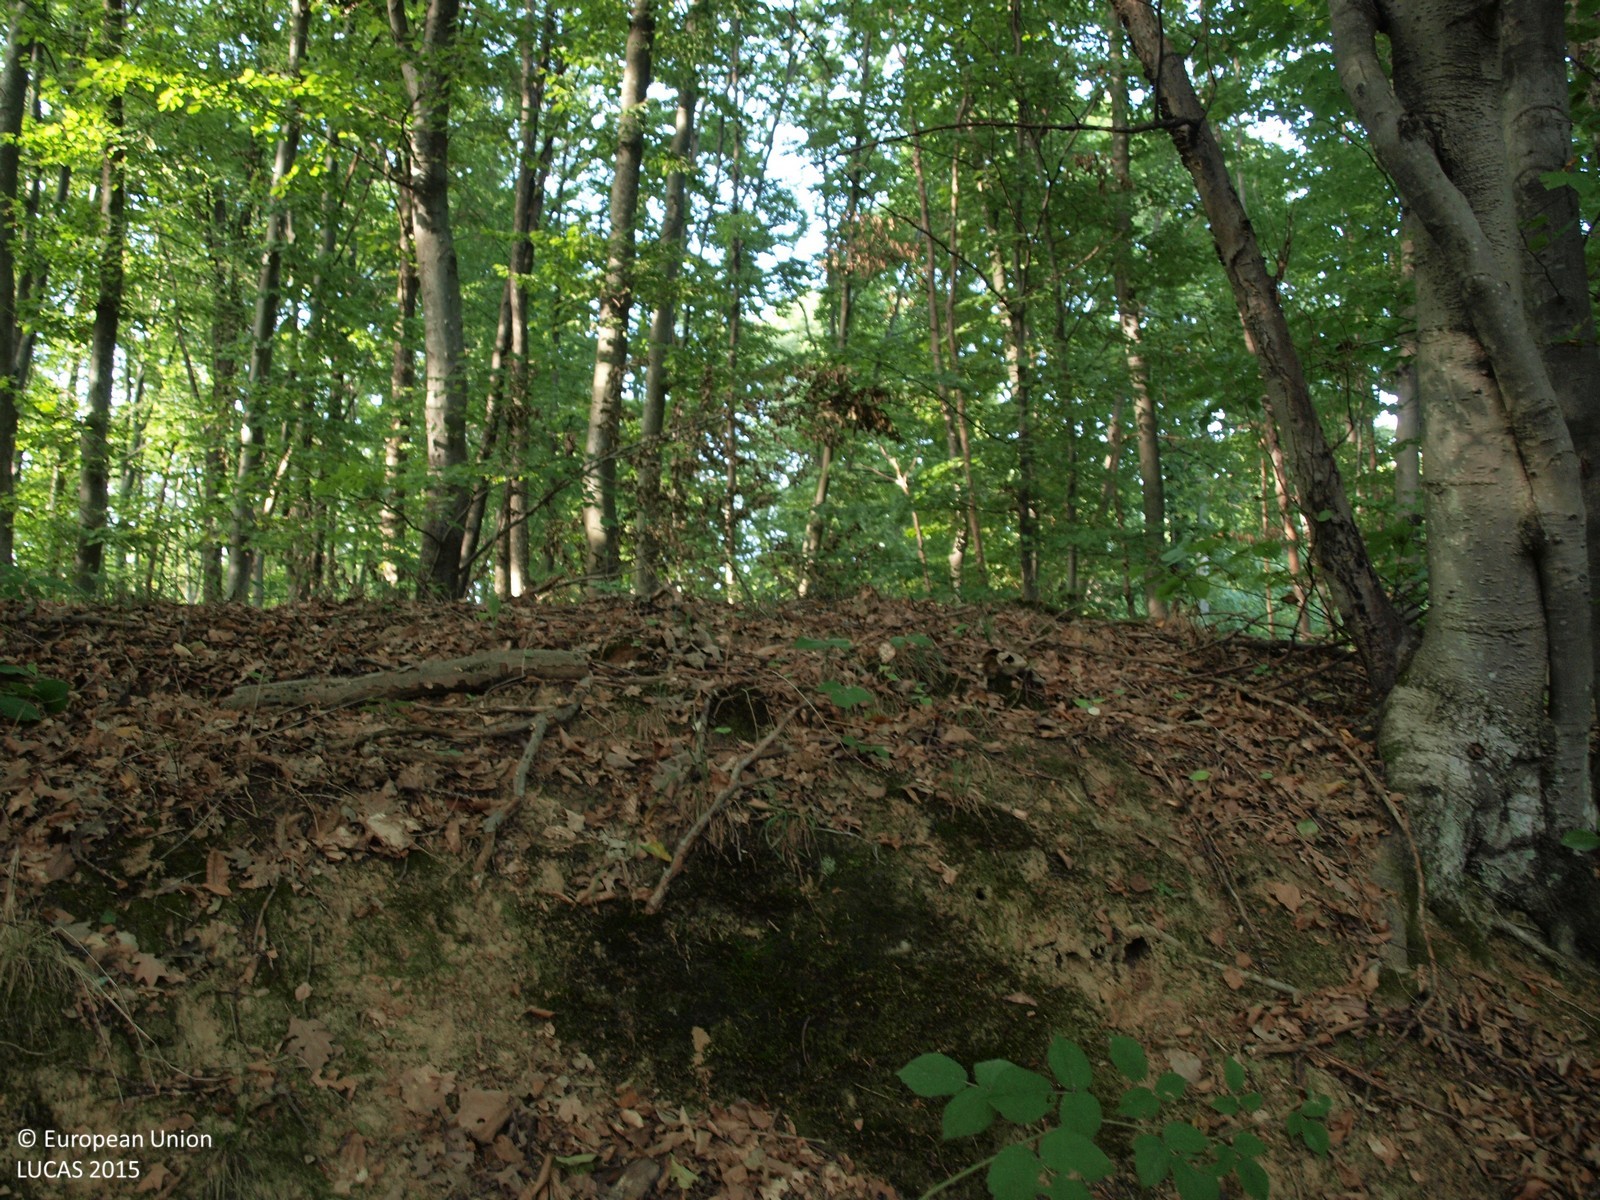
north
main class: Woodland
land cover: Broadleaved woodland
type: mesophytic deciduous forest
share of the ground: > 75 %
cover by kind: broadleaved forest trees 100 %
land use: Forestry
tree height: > 5 m
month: September
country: HR
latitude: 45.6012
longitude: 16.0616
